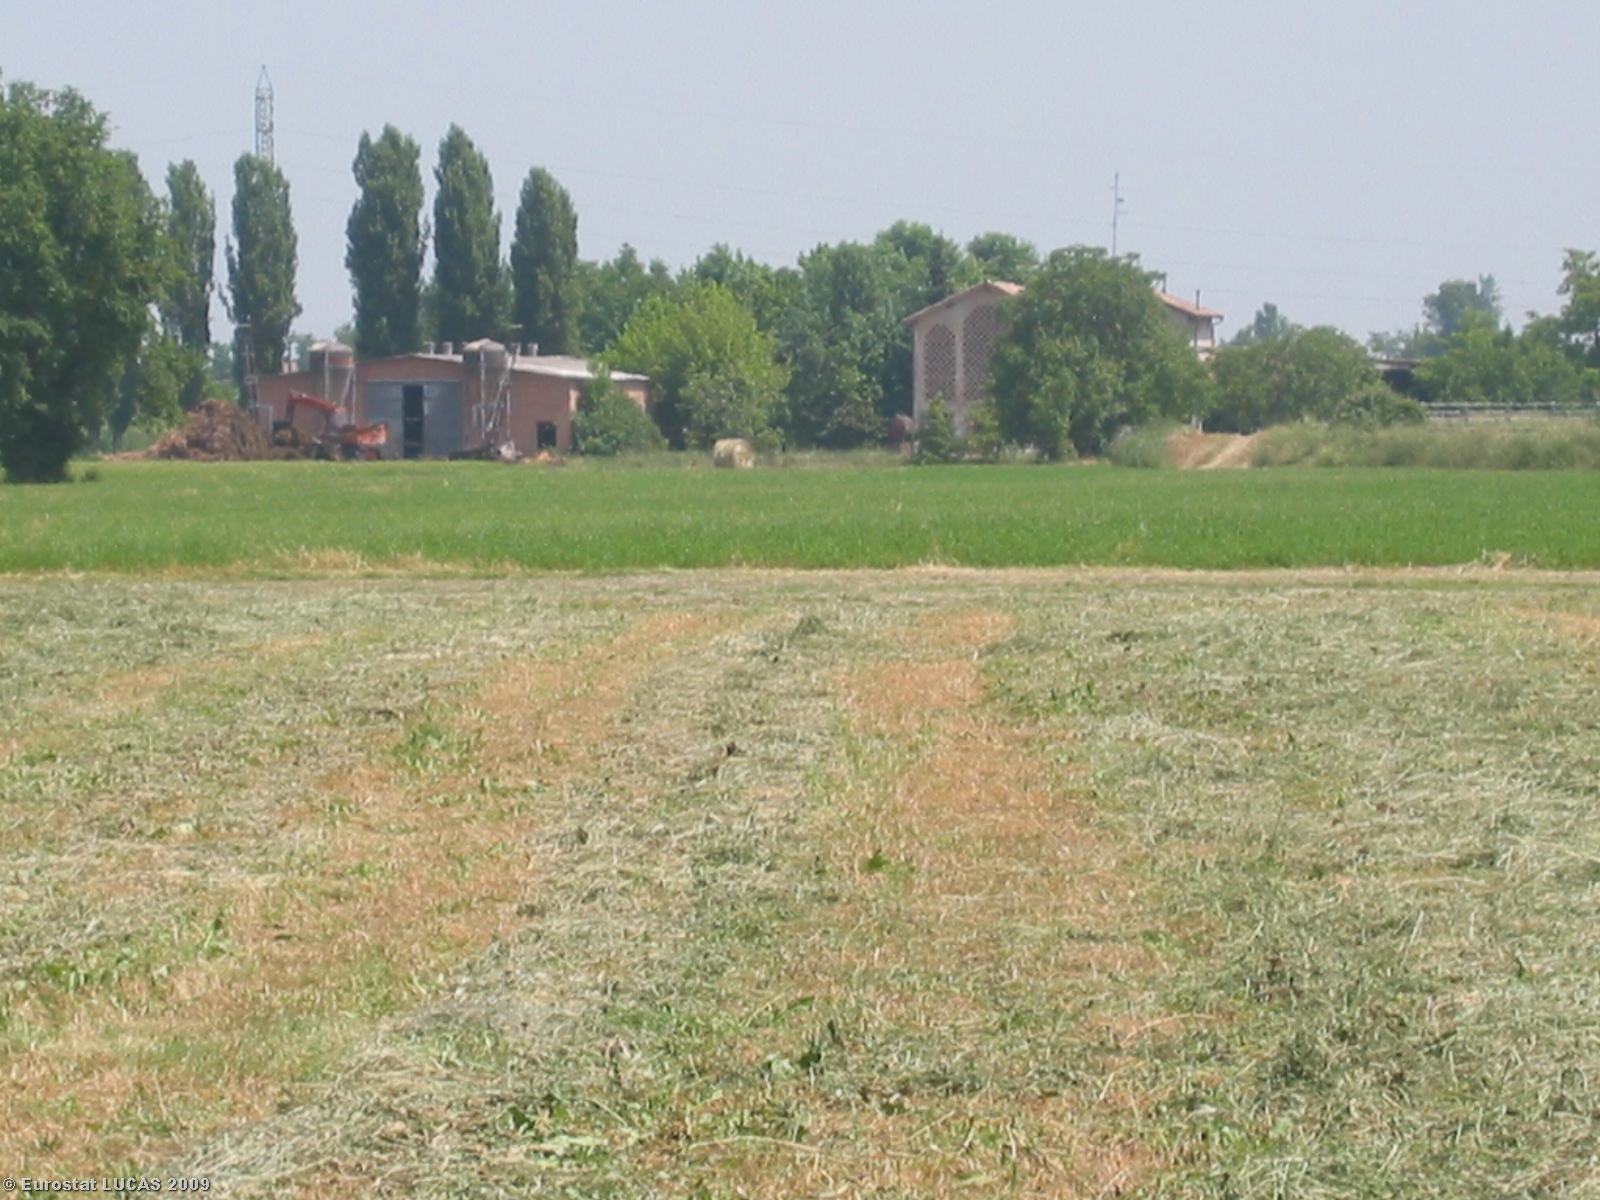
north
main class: Cropland
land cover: Common wheat
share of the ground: > 75 %
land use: Agriculture (excluding fallow land and kitchen gardens)
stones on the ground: < 10 %
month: June
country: IT
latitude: 44.7097
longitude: 10.5668
